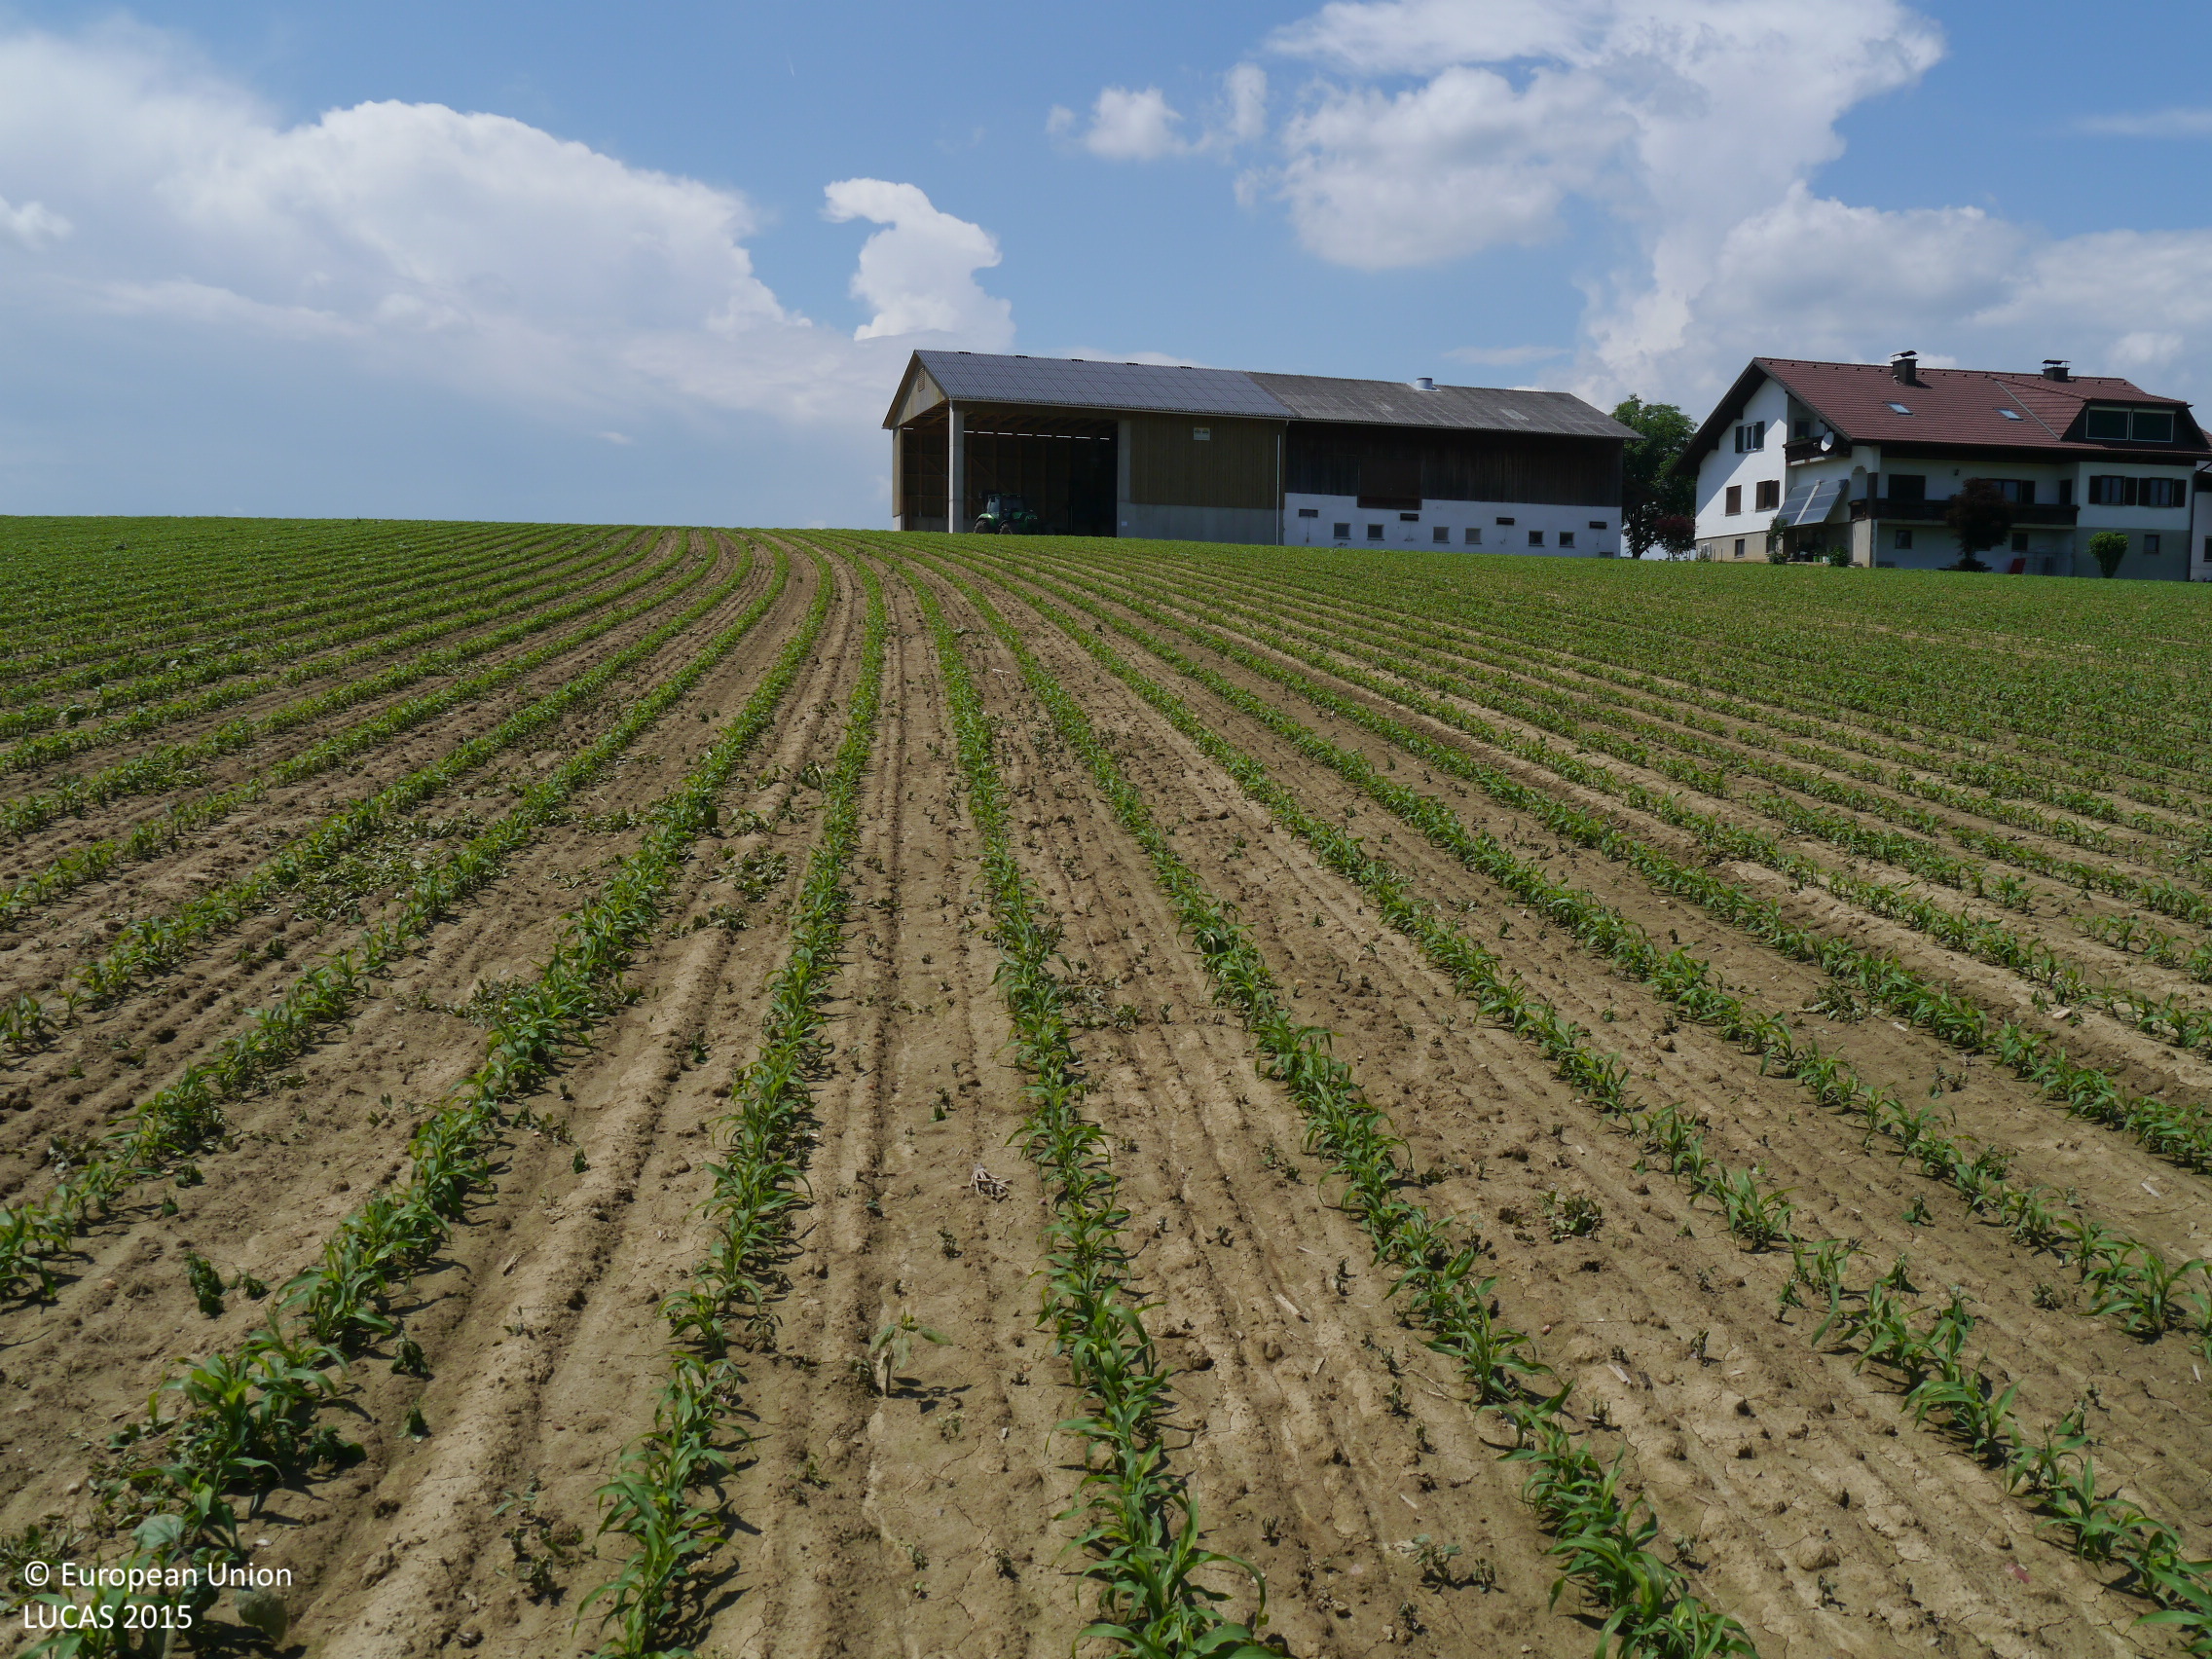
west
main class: Cropland
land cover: Maize
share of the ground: 25 - 50 %
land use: Agriculture (excluding fallow land and kitchen gardens)
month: June
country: AT
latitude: 46.8696
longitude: 15.6543
